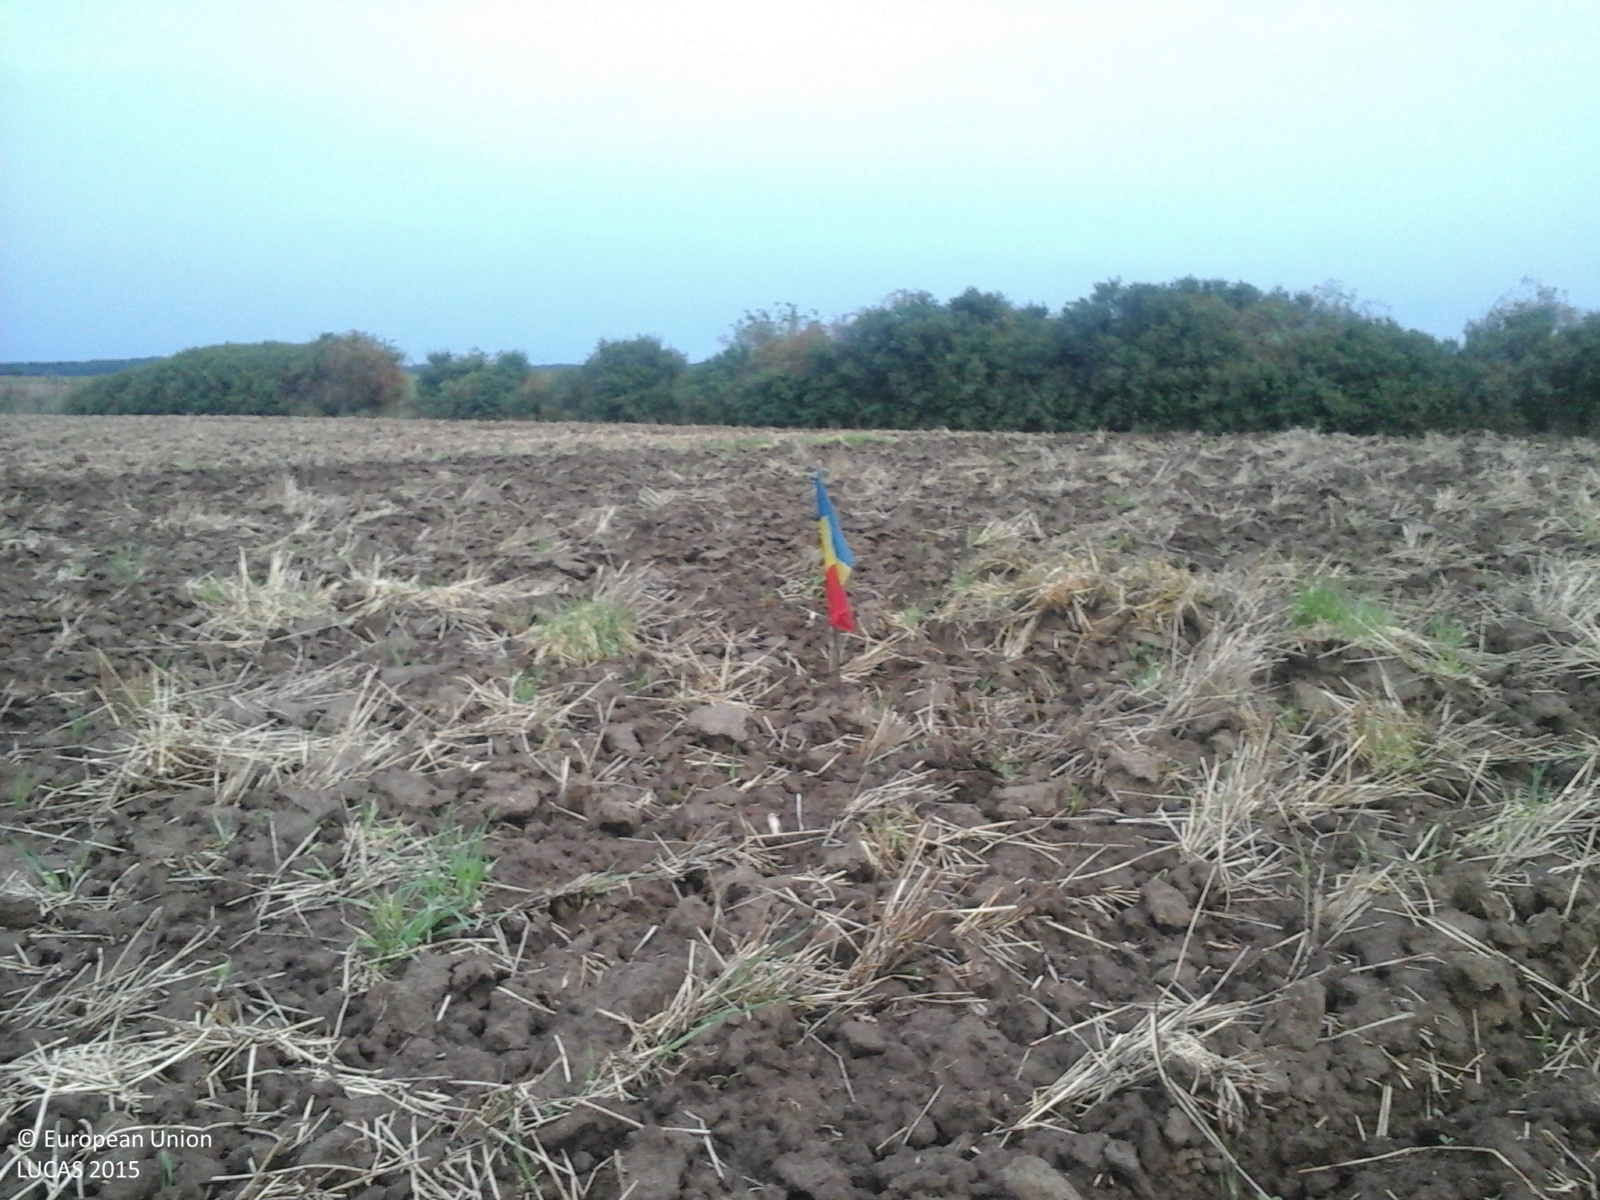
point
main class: Cropland
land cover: Common wheat
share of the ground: < 10 %
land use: Agriculture (excluding fallow land and kitchen gardens)
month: September
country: RO
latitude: 47.1637
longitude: 22.0127
